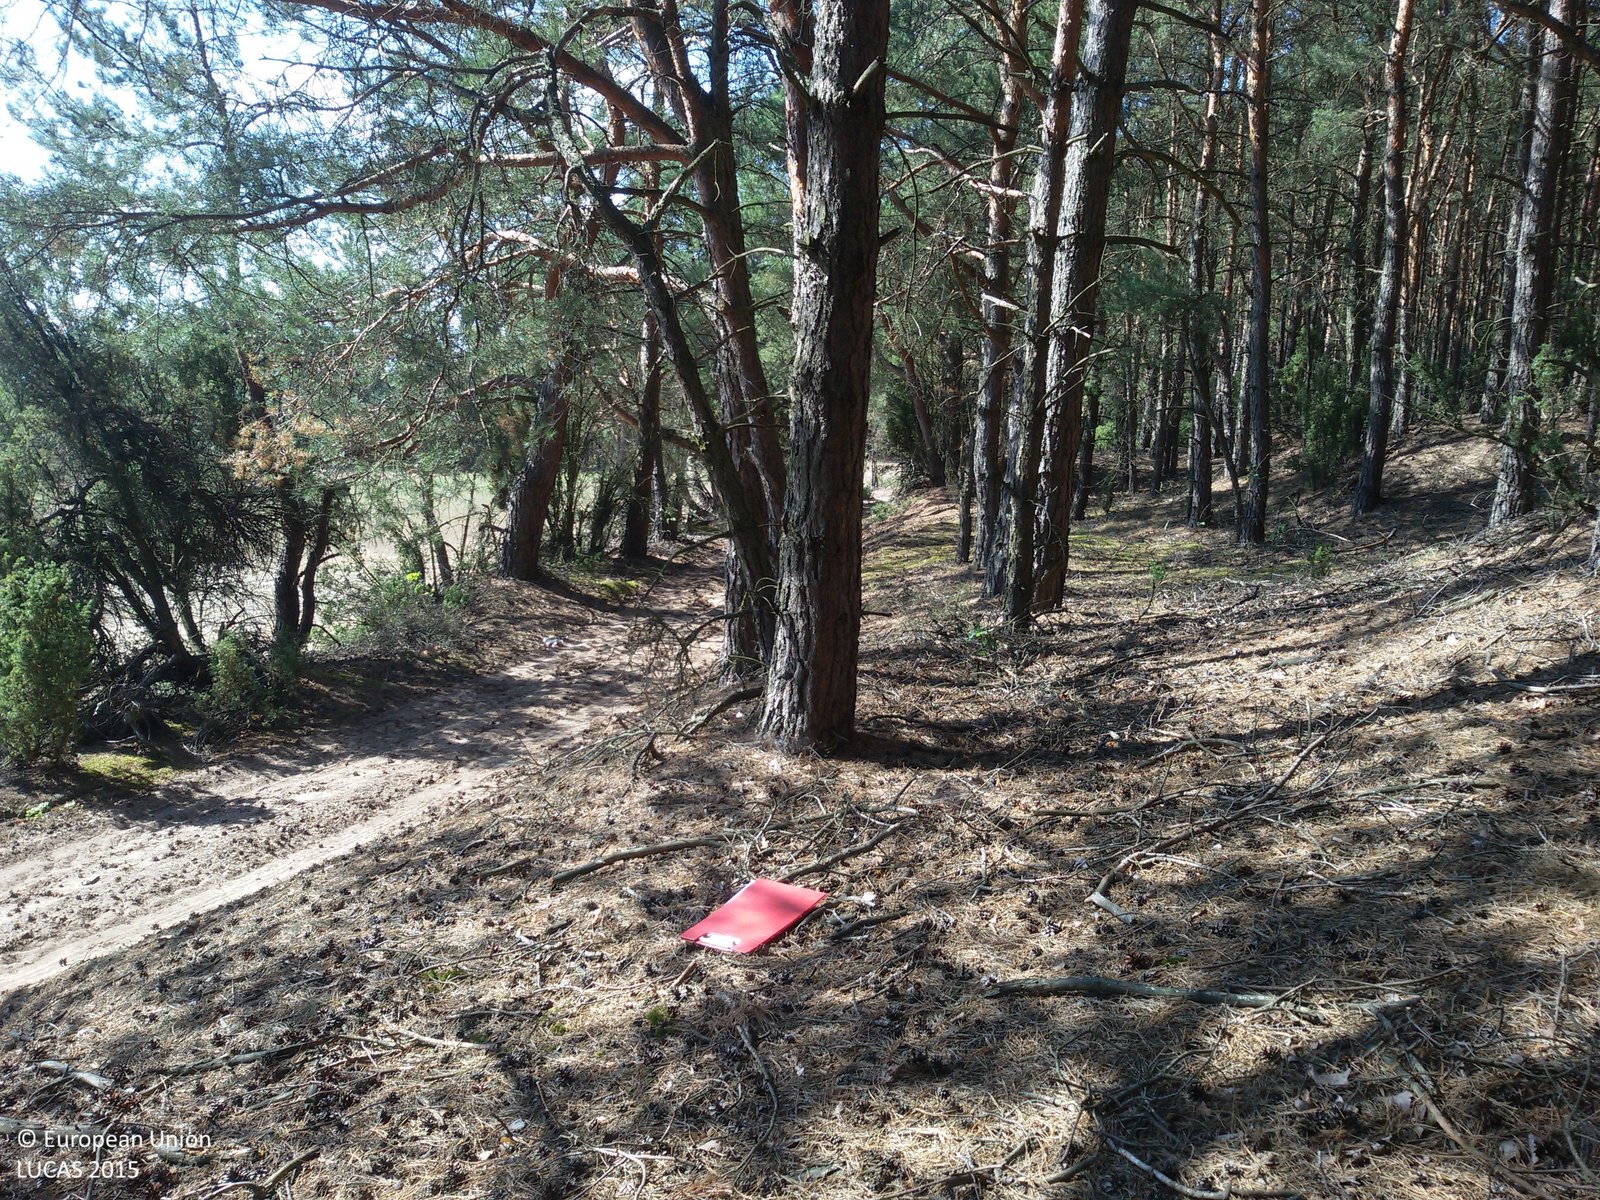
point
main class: Woodland
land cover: Pine dominated coniferous woodland
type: hemiboreal forest and nemoral coniferous forest and mixed broadleaved-coniferous forest
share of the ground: > 75 %
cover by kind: coniferous forest trees 80 %, lichens and mosses 15 %, herbaceous plants 5 %
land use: Forestry
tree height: > 5 m
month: August
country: PL
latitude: 52.8173
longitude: 20.0785
